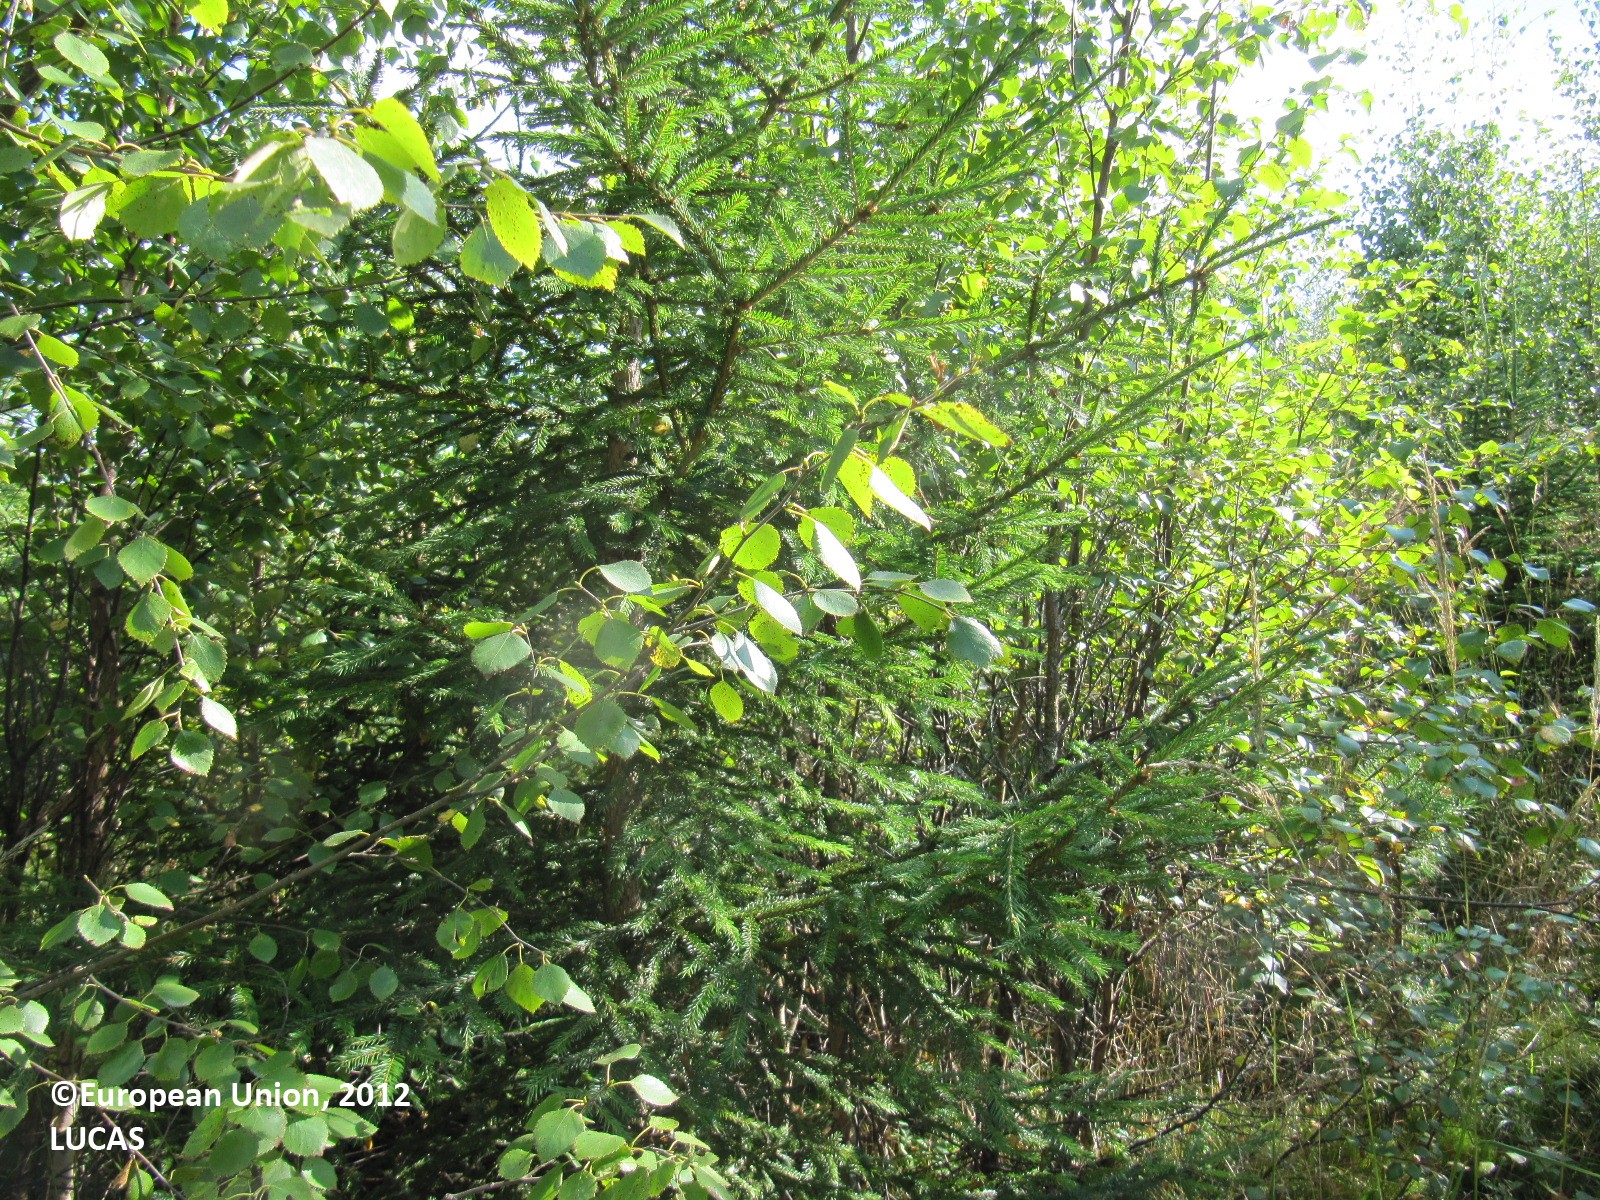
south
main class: Woodland
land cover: Other mixed woodland
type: boreal forest
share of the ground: > 75 %
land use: Forestry
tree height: < 5 m
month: August
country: FI
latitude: 60.6267
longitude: 24.6011
